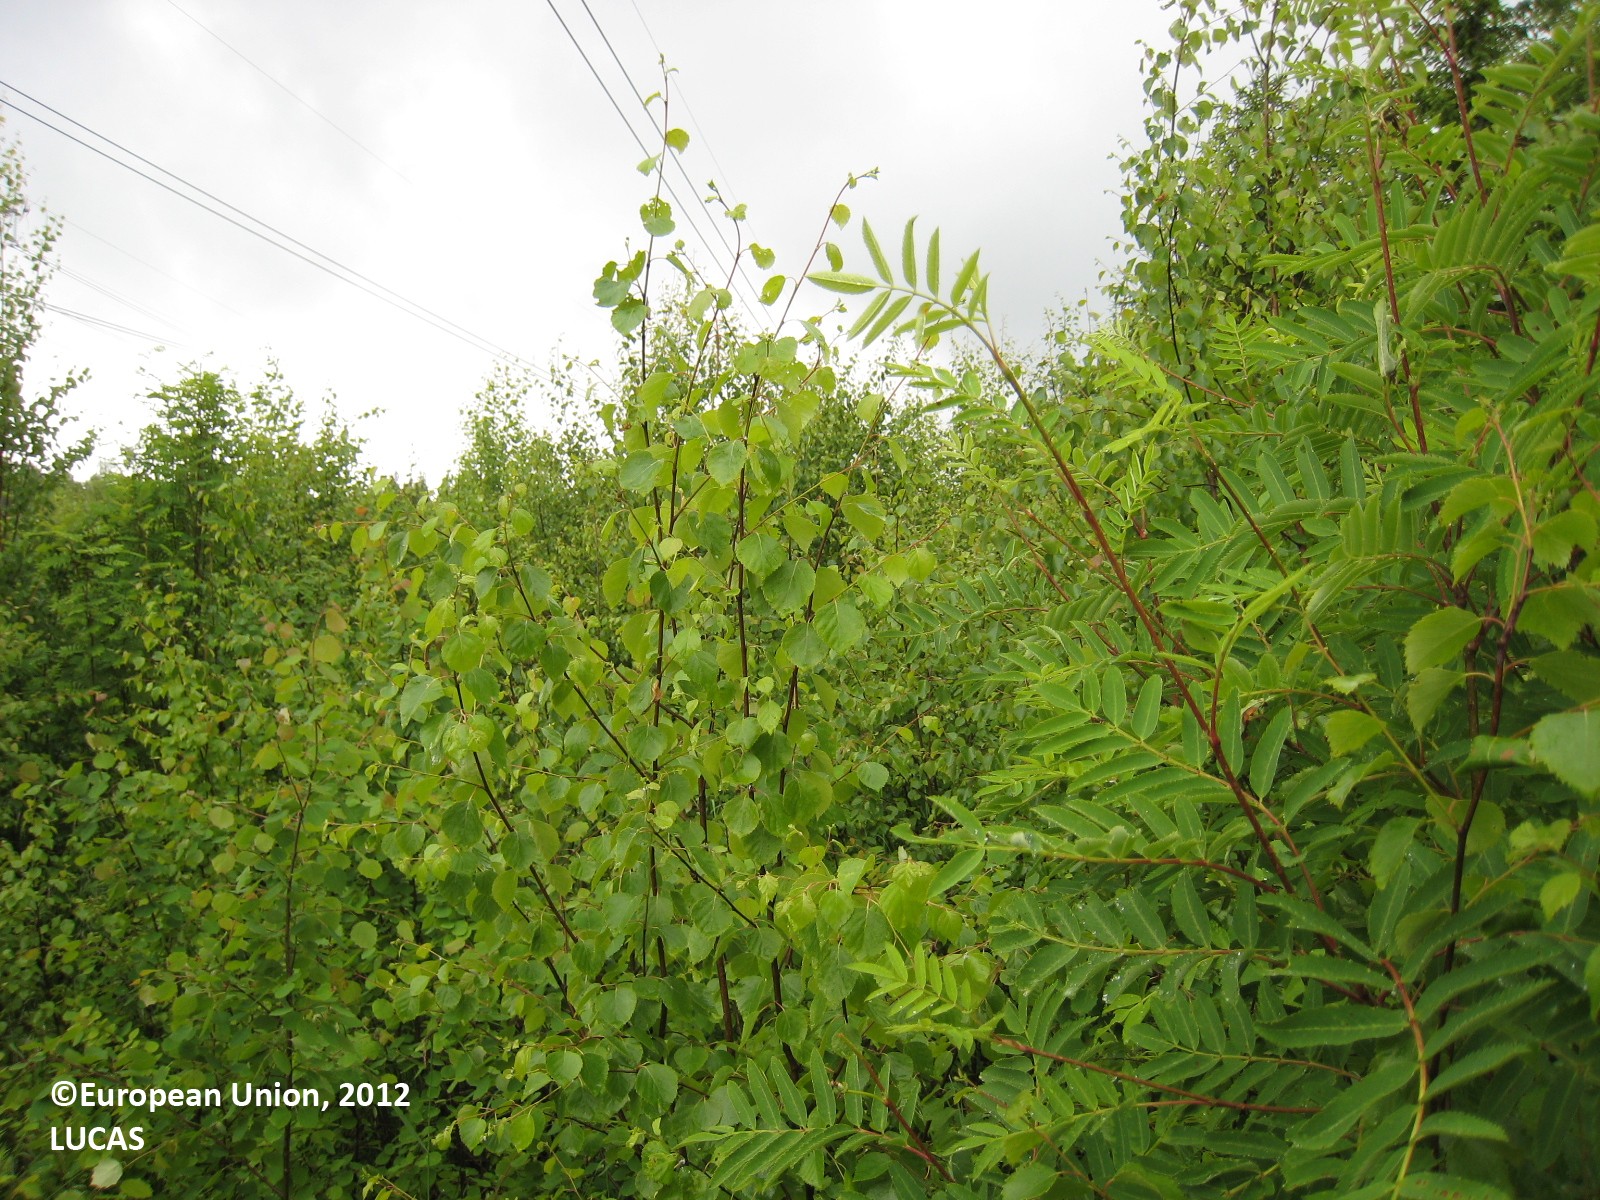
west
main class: Woodland
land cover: Broadleaved woodland
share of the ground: > 75 %
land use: Energy production
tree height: < 5 m
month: June
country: FI
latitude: 62.3004
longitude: 26.3533
